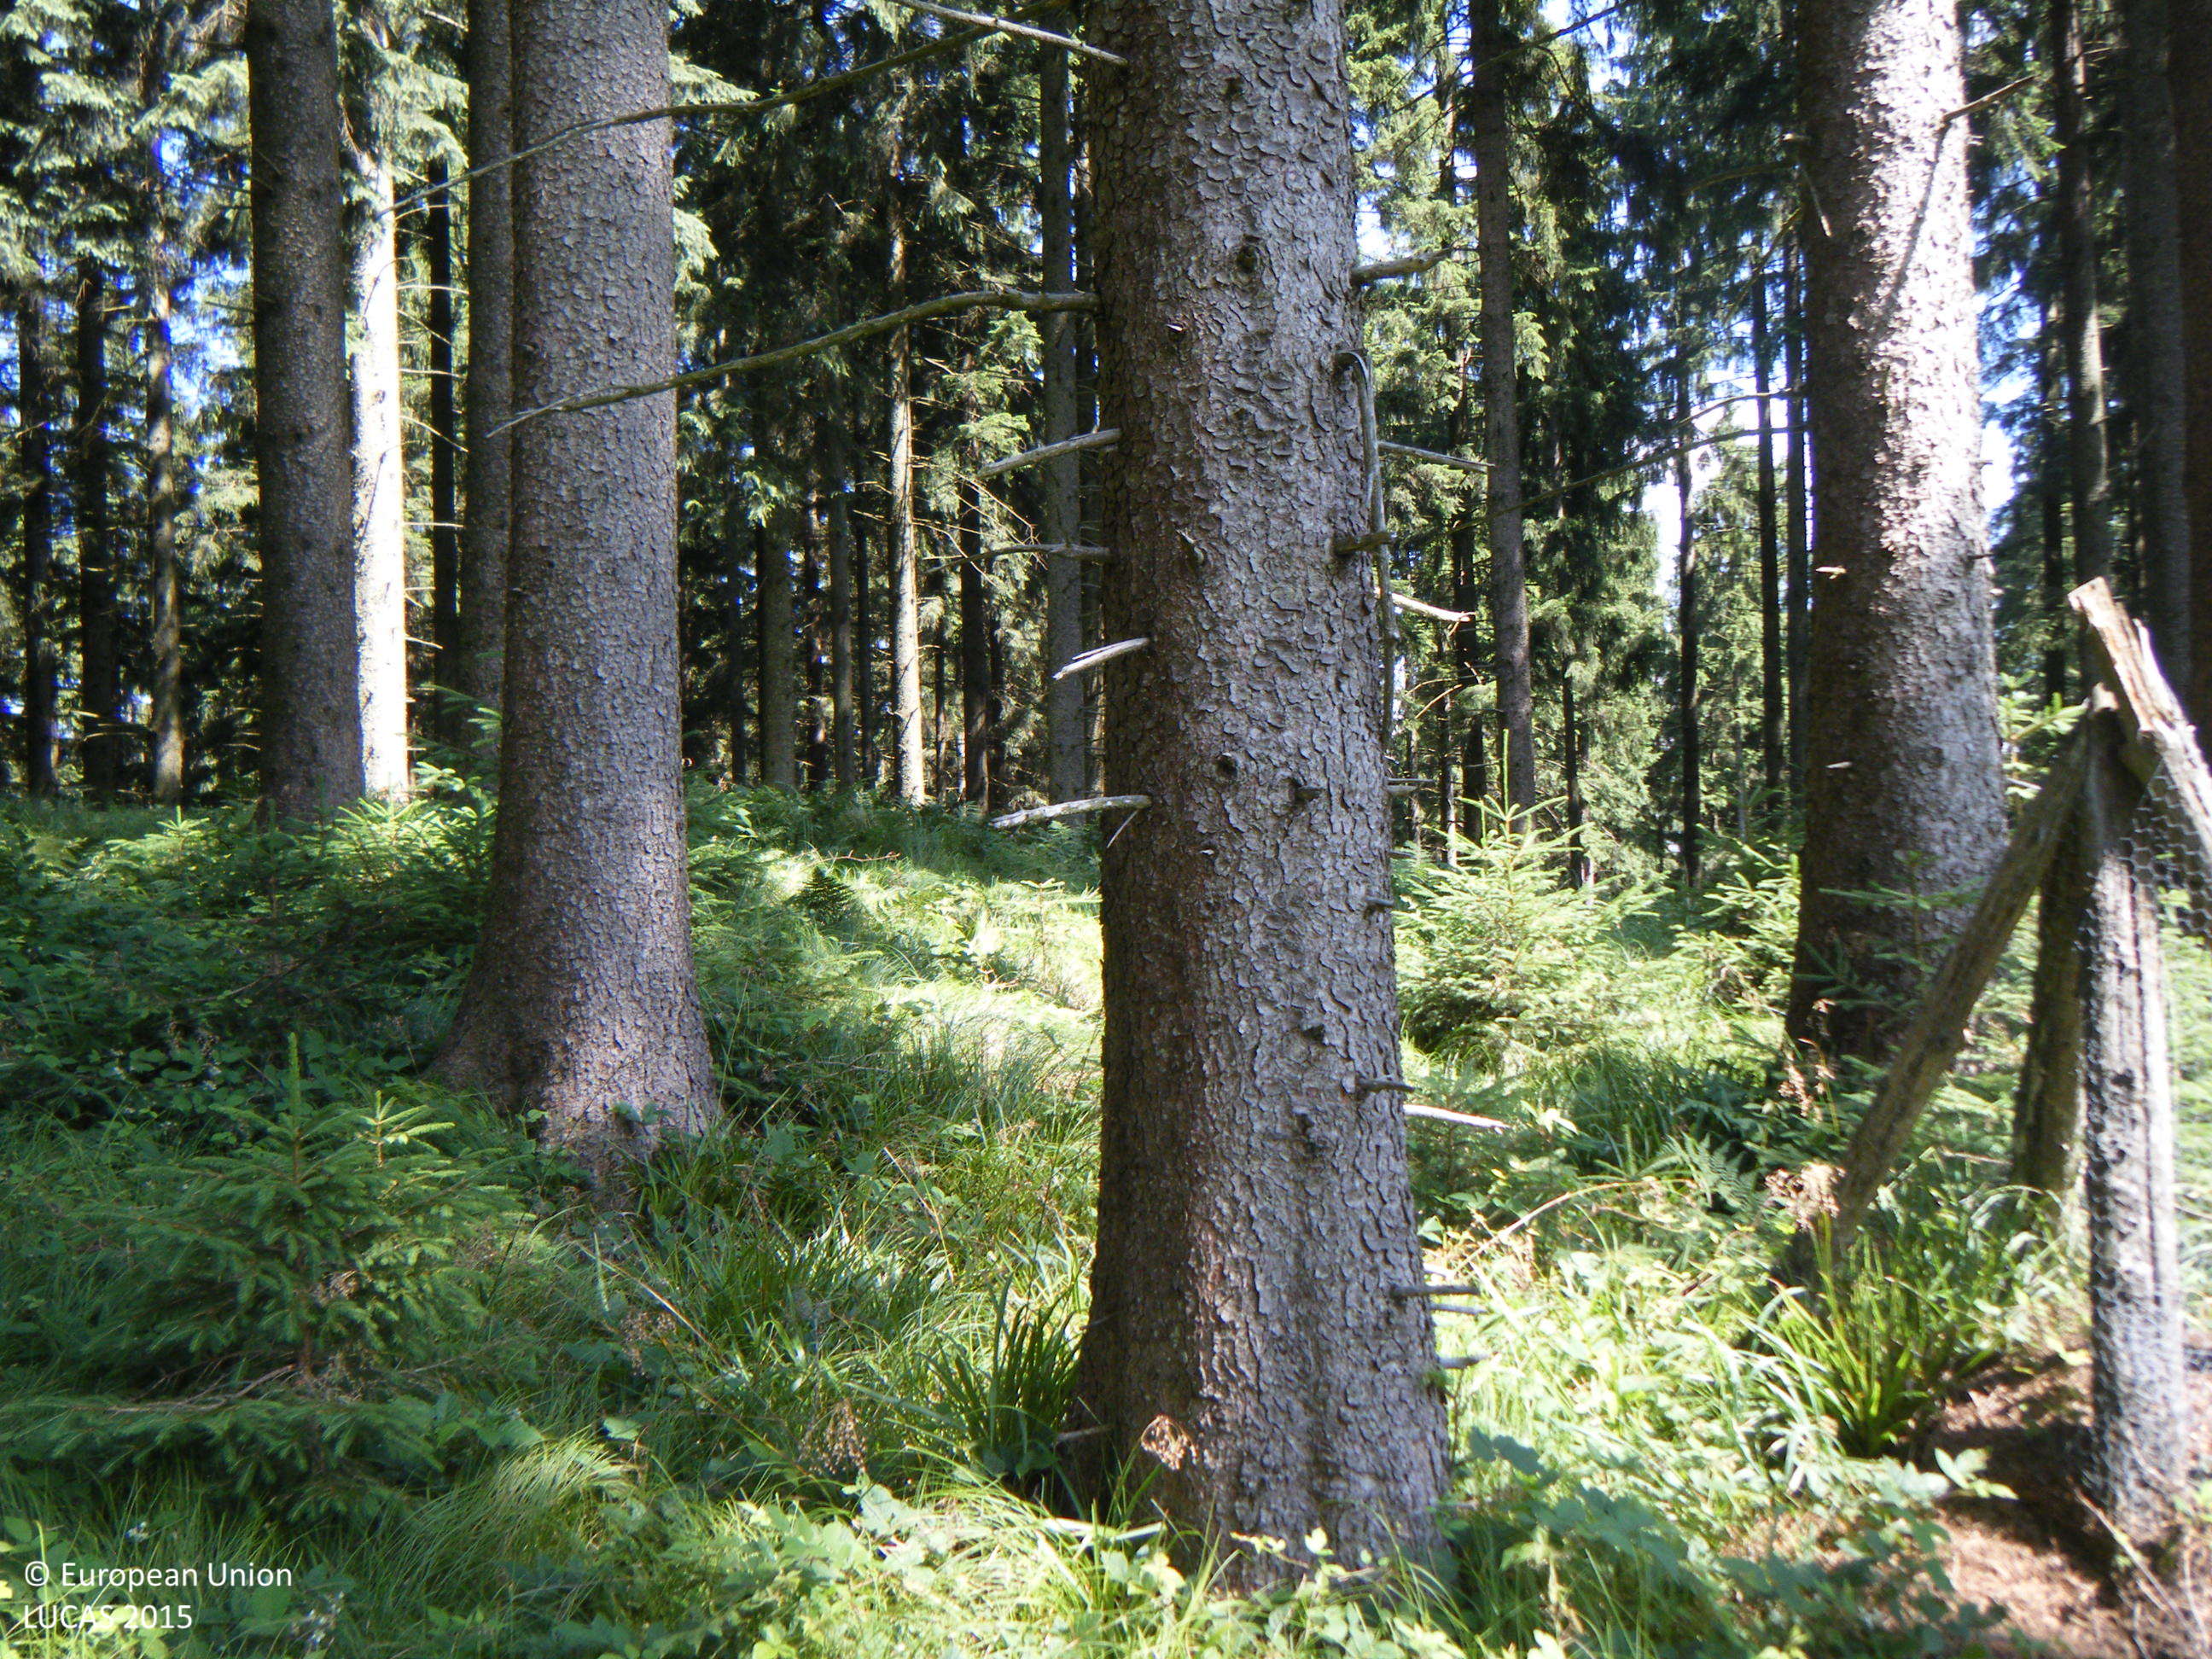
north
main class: Woodland
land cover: Spruce dominated coniferous woodland
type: alpine coniferous forest
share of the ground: > 75 %
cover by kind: coniferous forest trees 80 %, shrubs 10 %, herbaceous plants 10 %
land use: Forestry
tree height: > 5 m
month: July
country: AT
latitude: 47.8810
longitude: 13.4622
